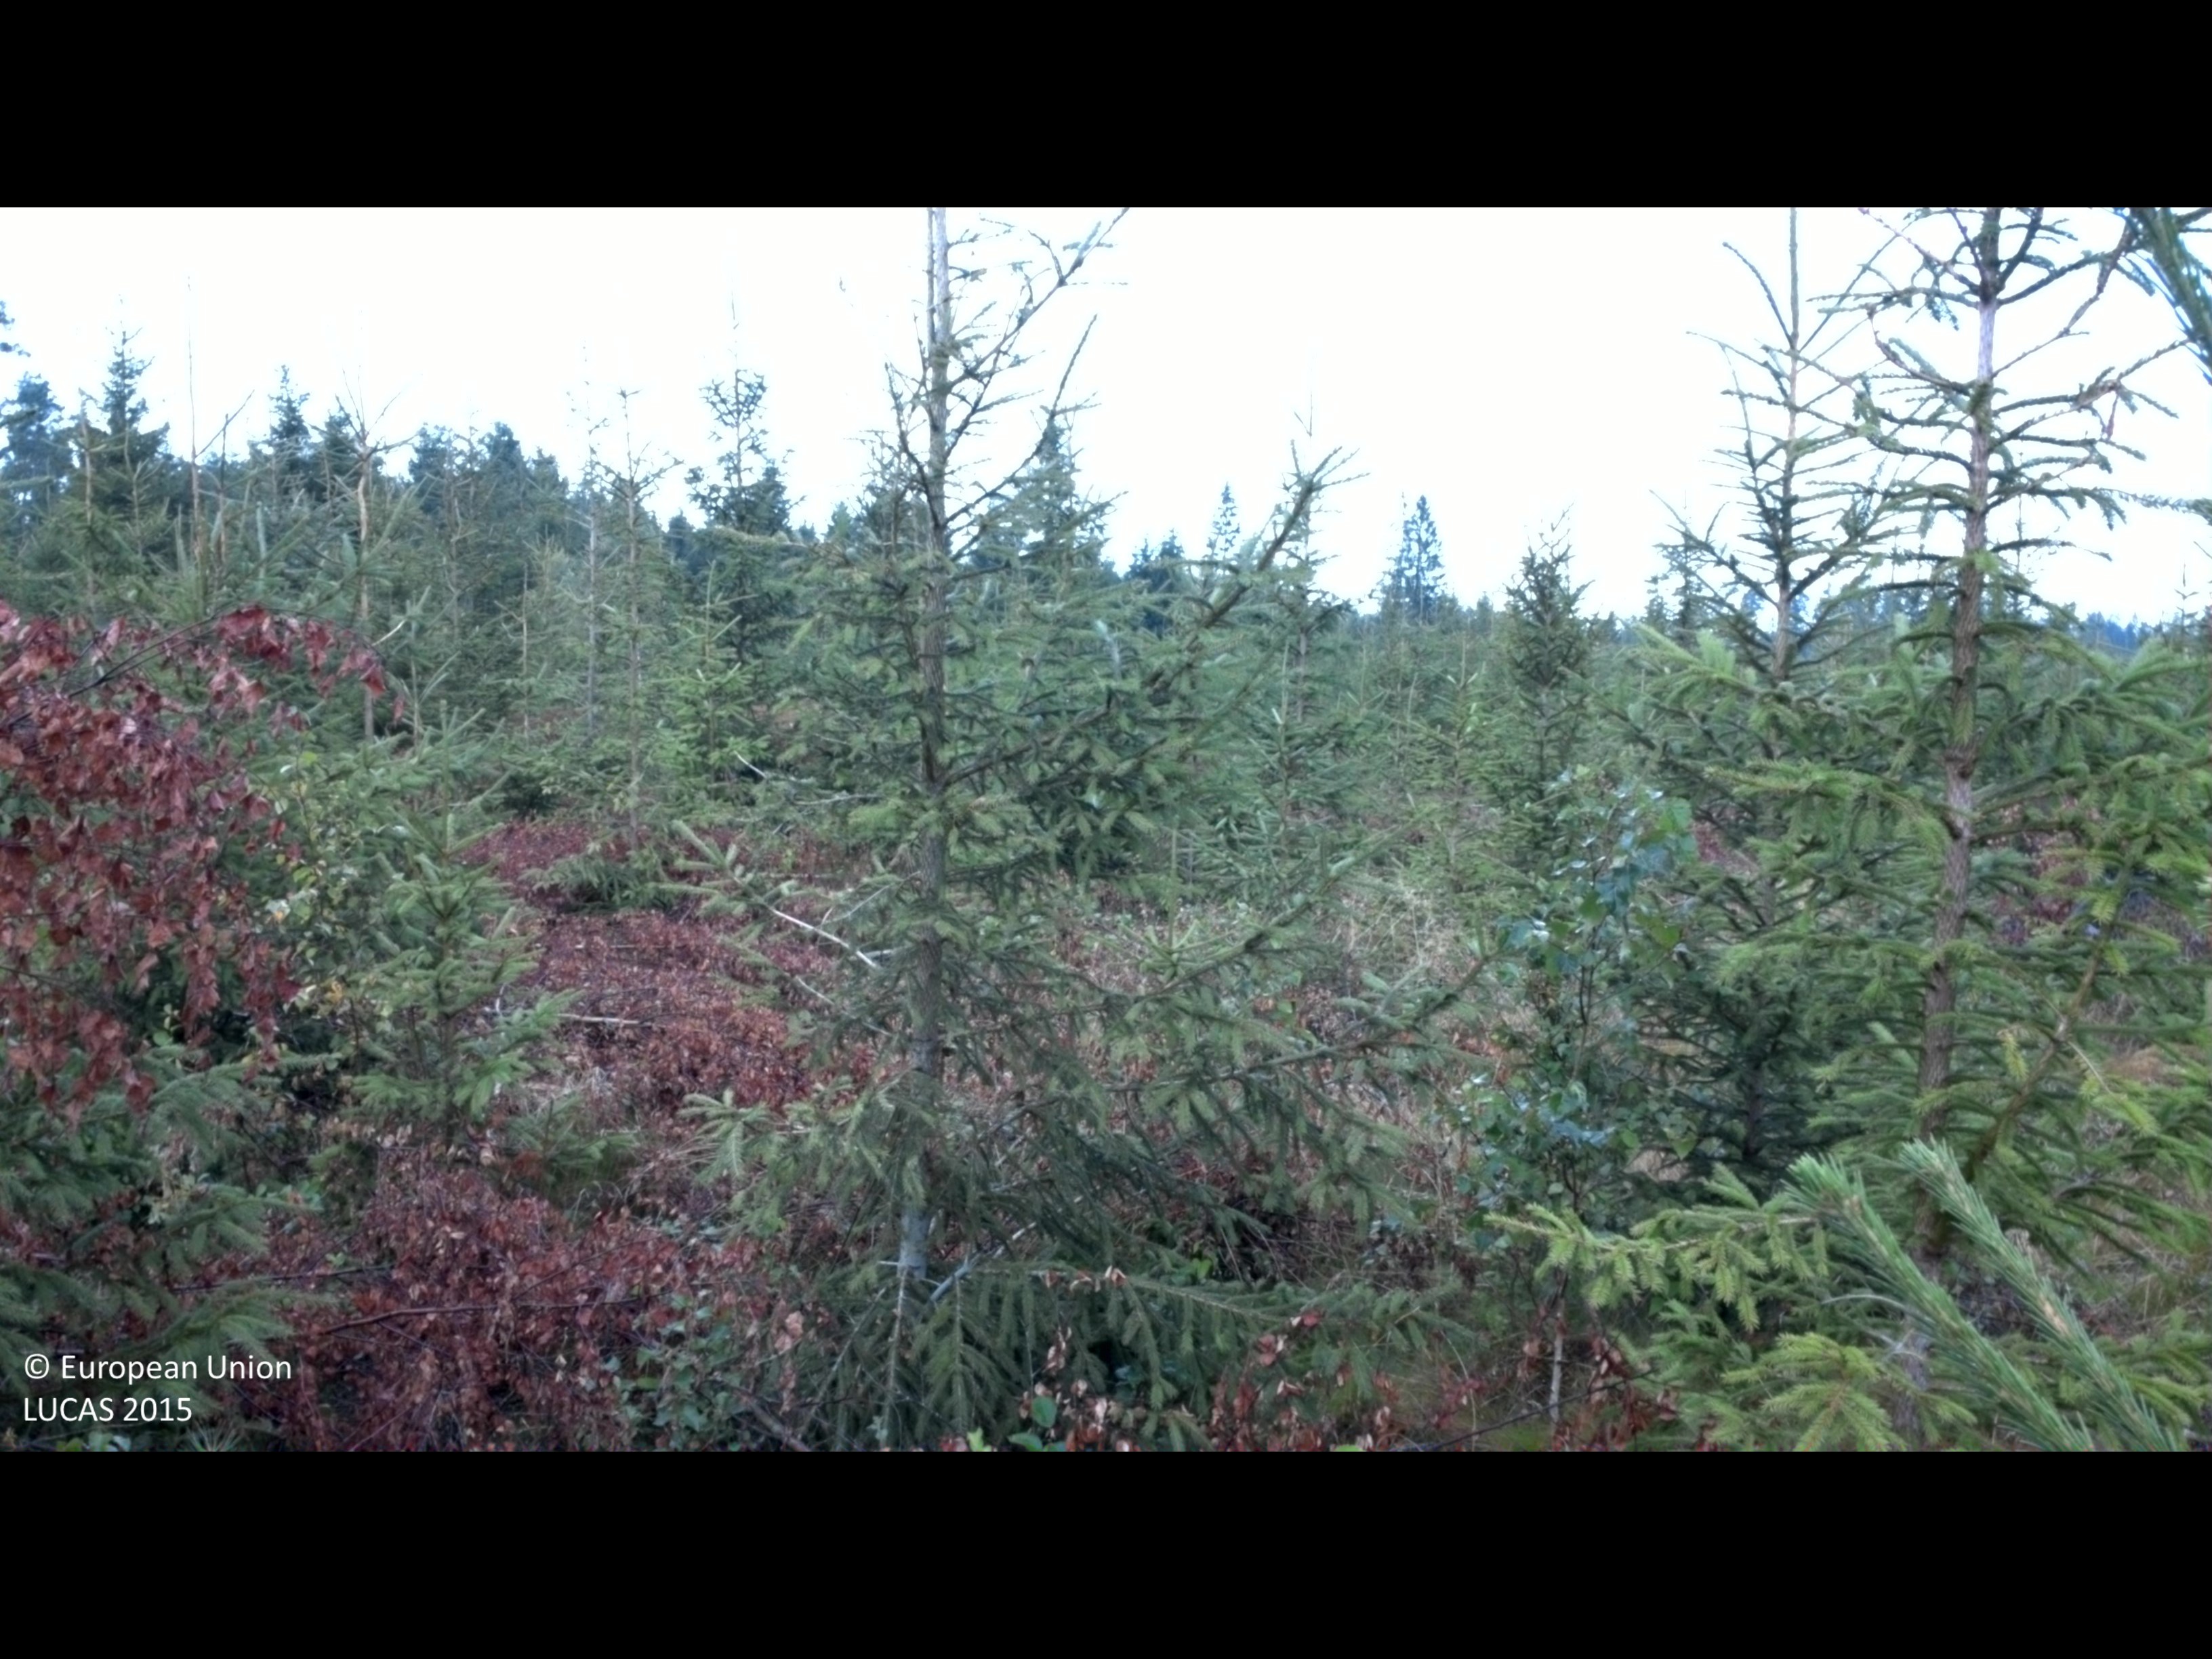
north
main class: Woodland
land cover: Spruce dominated coniferous woodland
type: boreal forest
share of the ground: 50 - 75 %
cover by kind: coniferous forest trees 60 %, shrubs 20 %, herbaceous plants 15 %, broadleaved forest trees 5 %
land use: Forestry
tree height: < 5 m
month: August
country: SE
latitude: 56.9216
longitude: 13.2000
